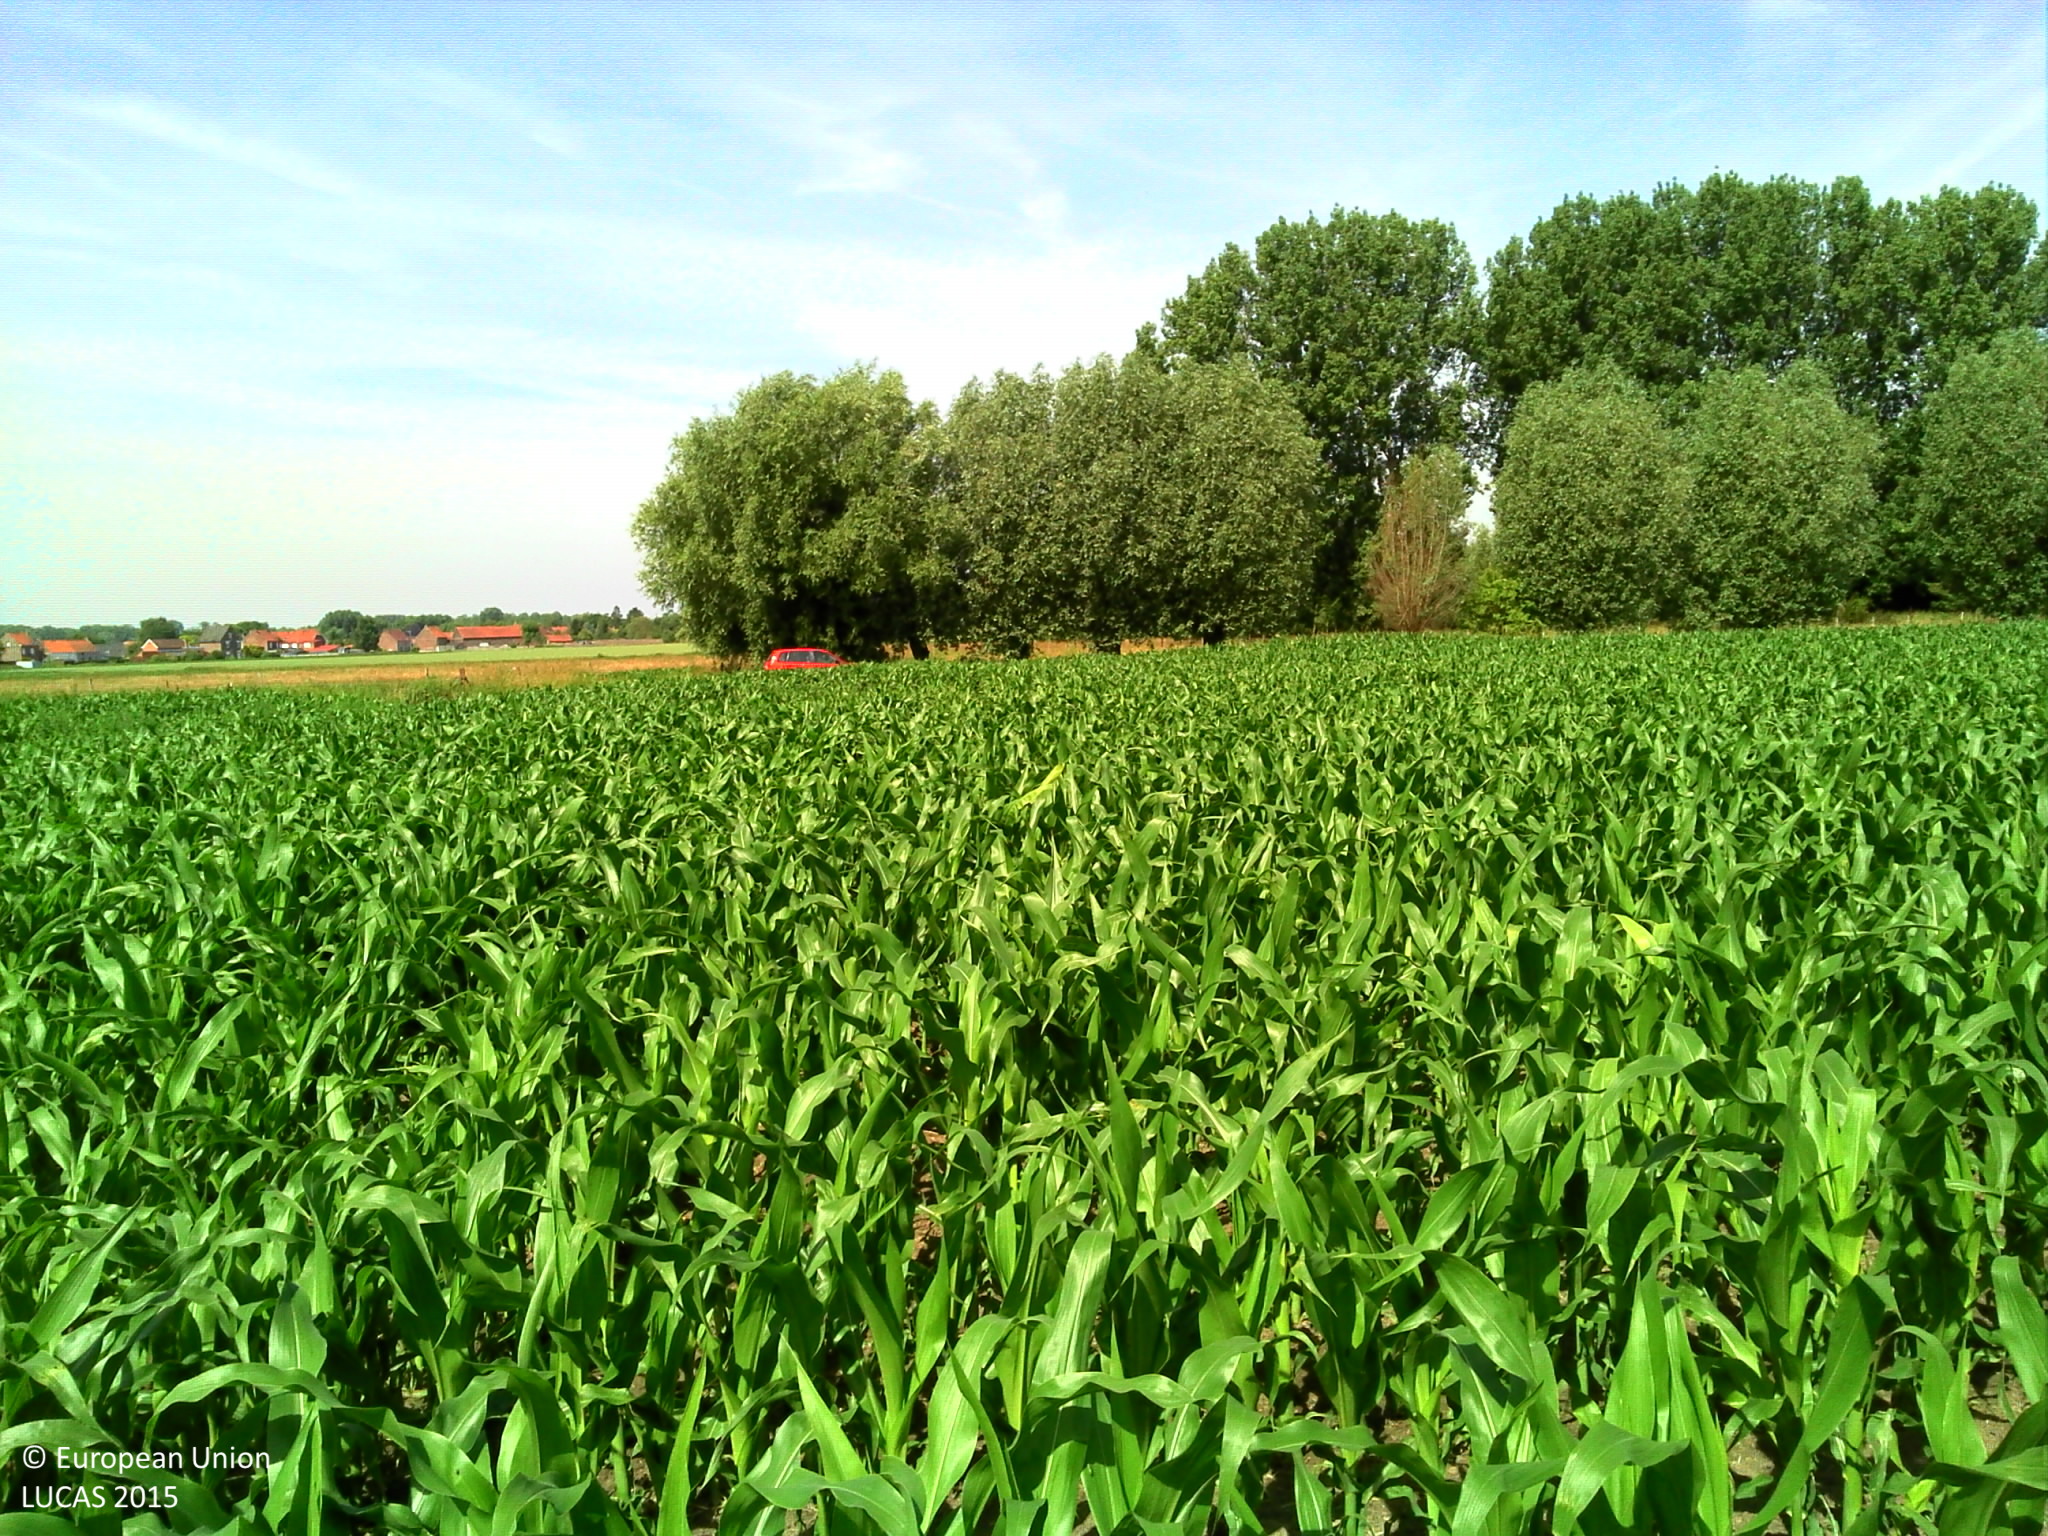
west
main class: Cropland
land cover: Maize
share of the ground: 50 - 75 %
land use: Agriculture (excluding fallow land and kitchen gardens)
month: June
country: BE
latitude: 50.5066
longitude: 3.5487
